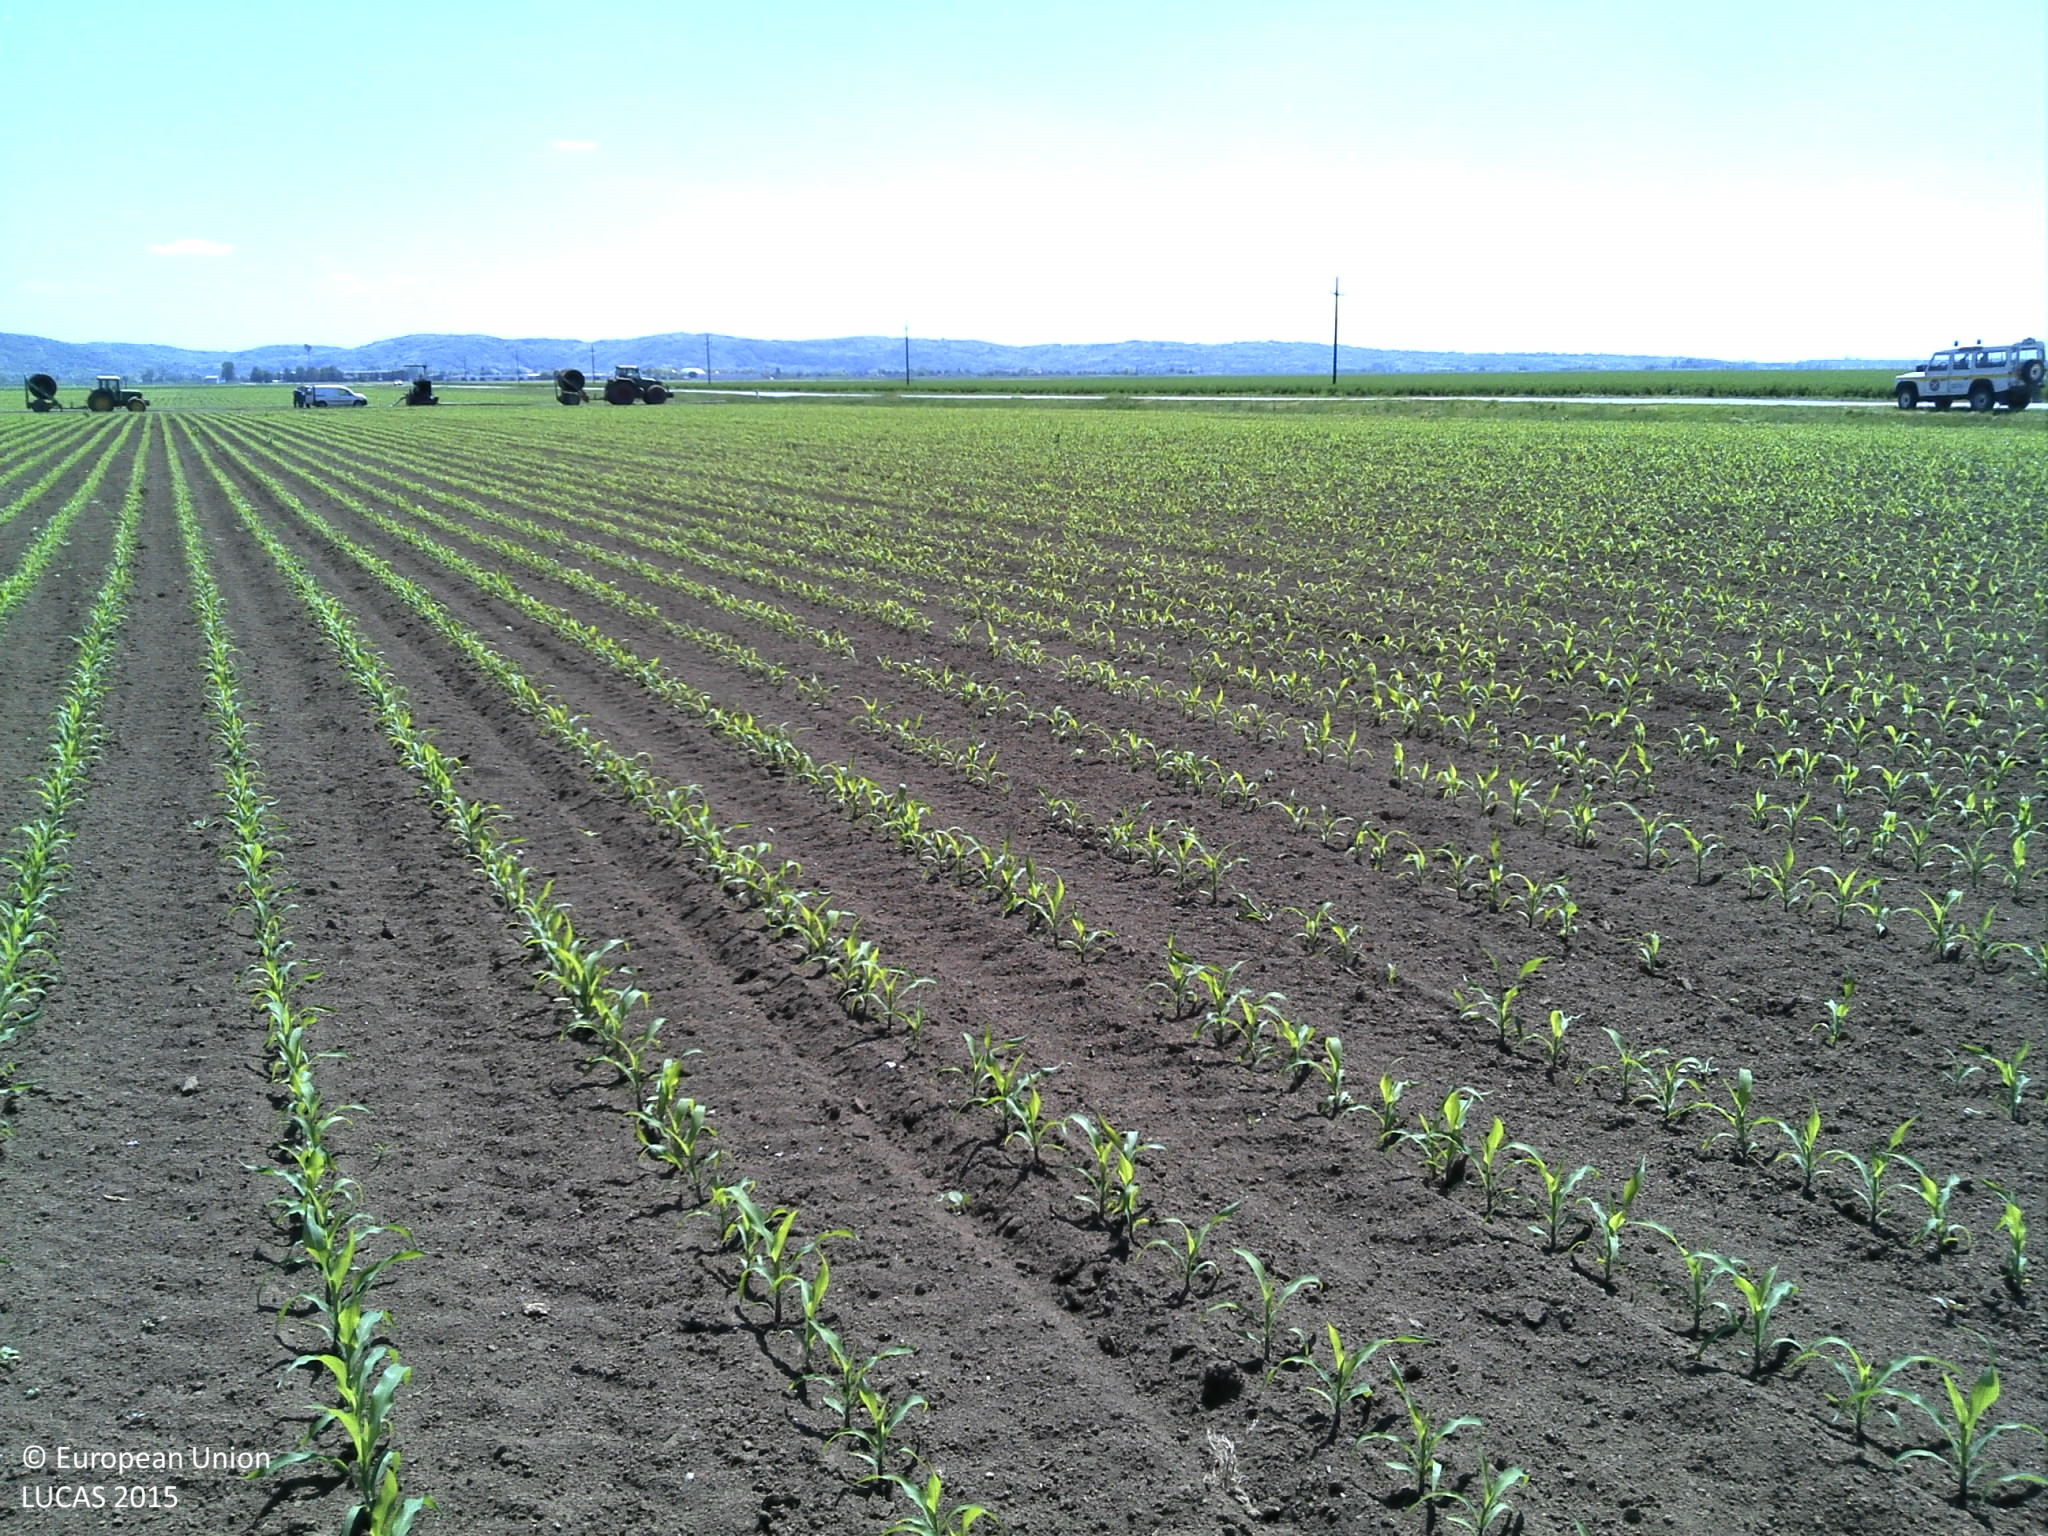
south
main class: Cropland
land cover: Maize
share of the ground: < 10 %
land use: Agriculture (excluding fallow land and kitchen gardens)
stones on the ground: < 10 %
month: May
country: HR
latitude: 45.8375
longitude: 18.6476
